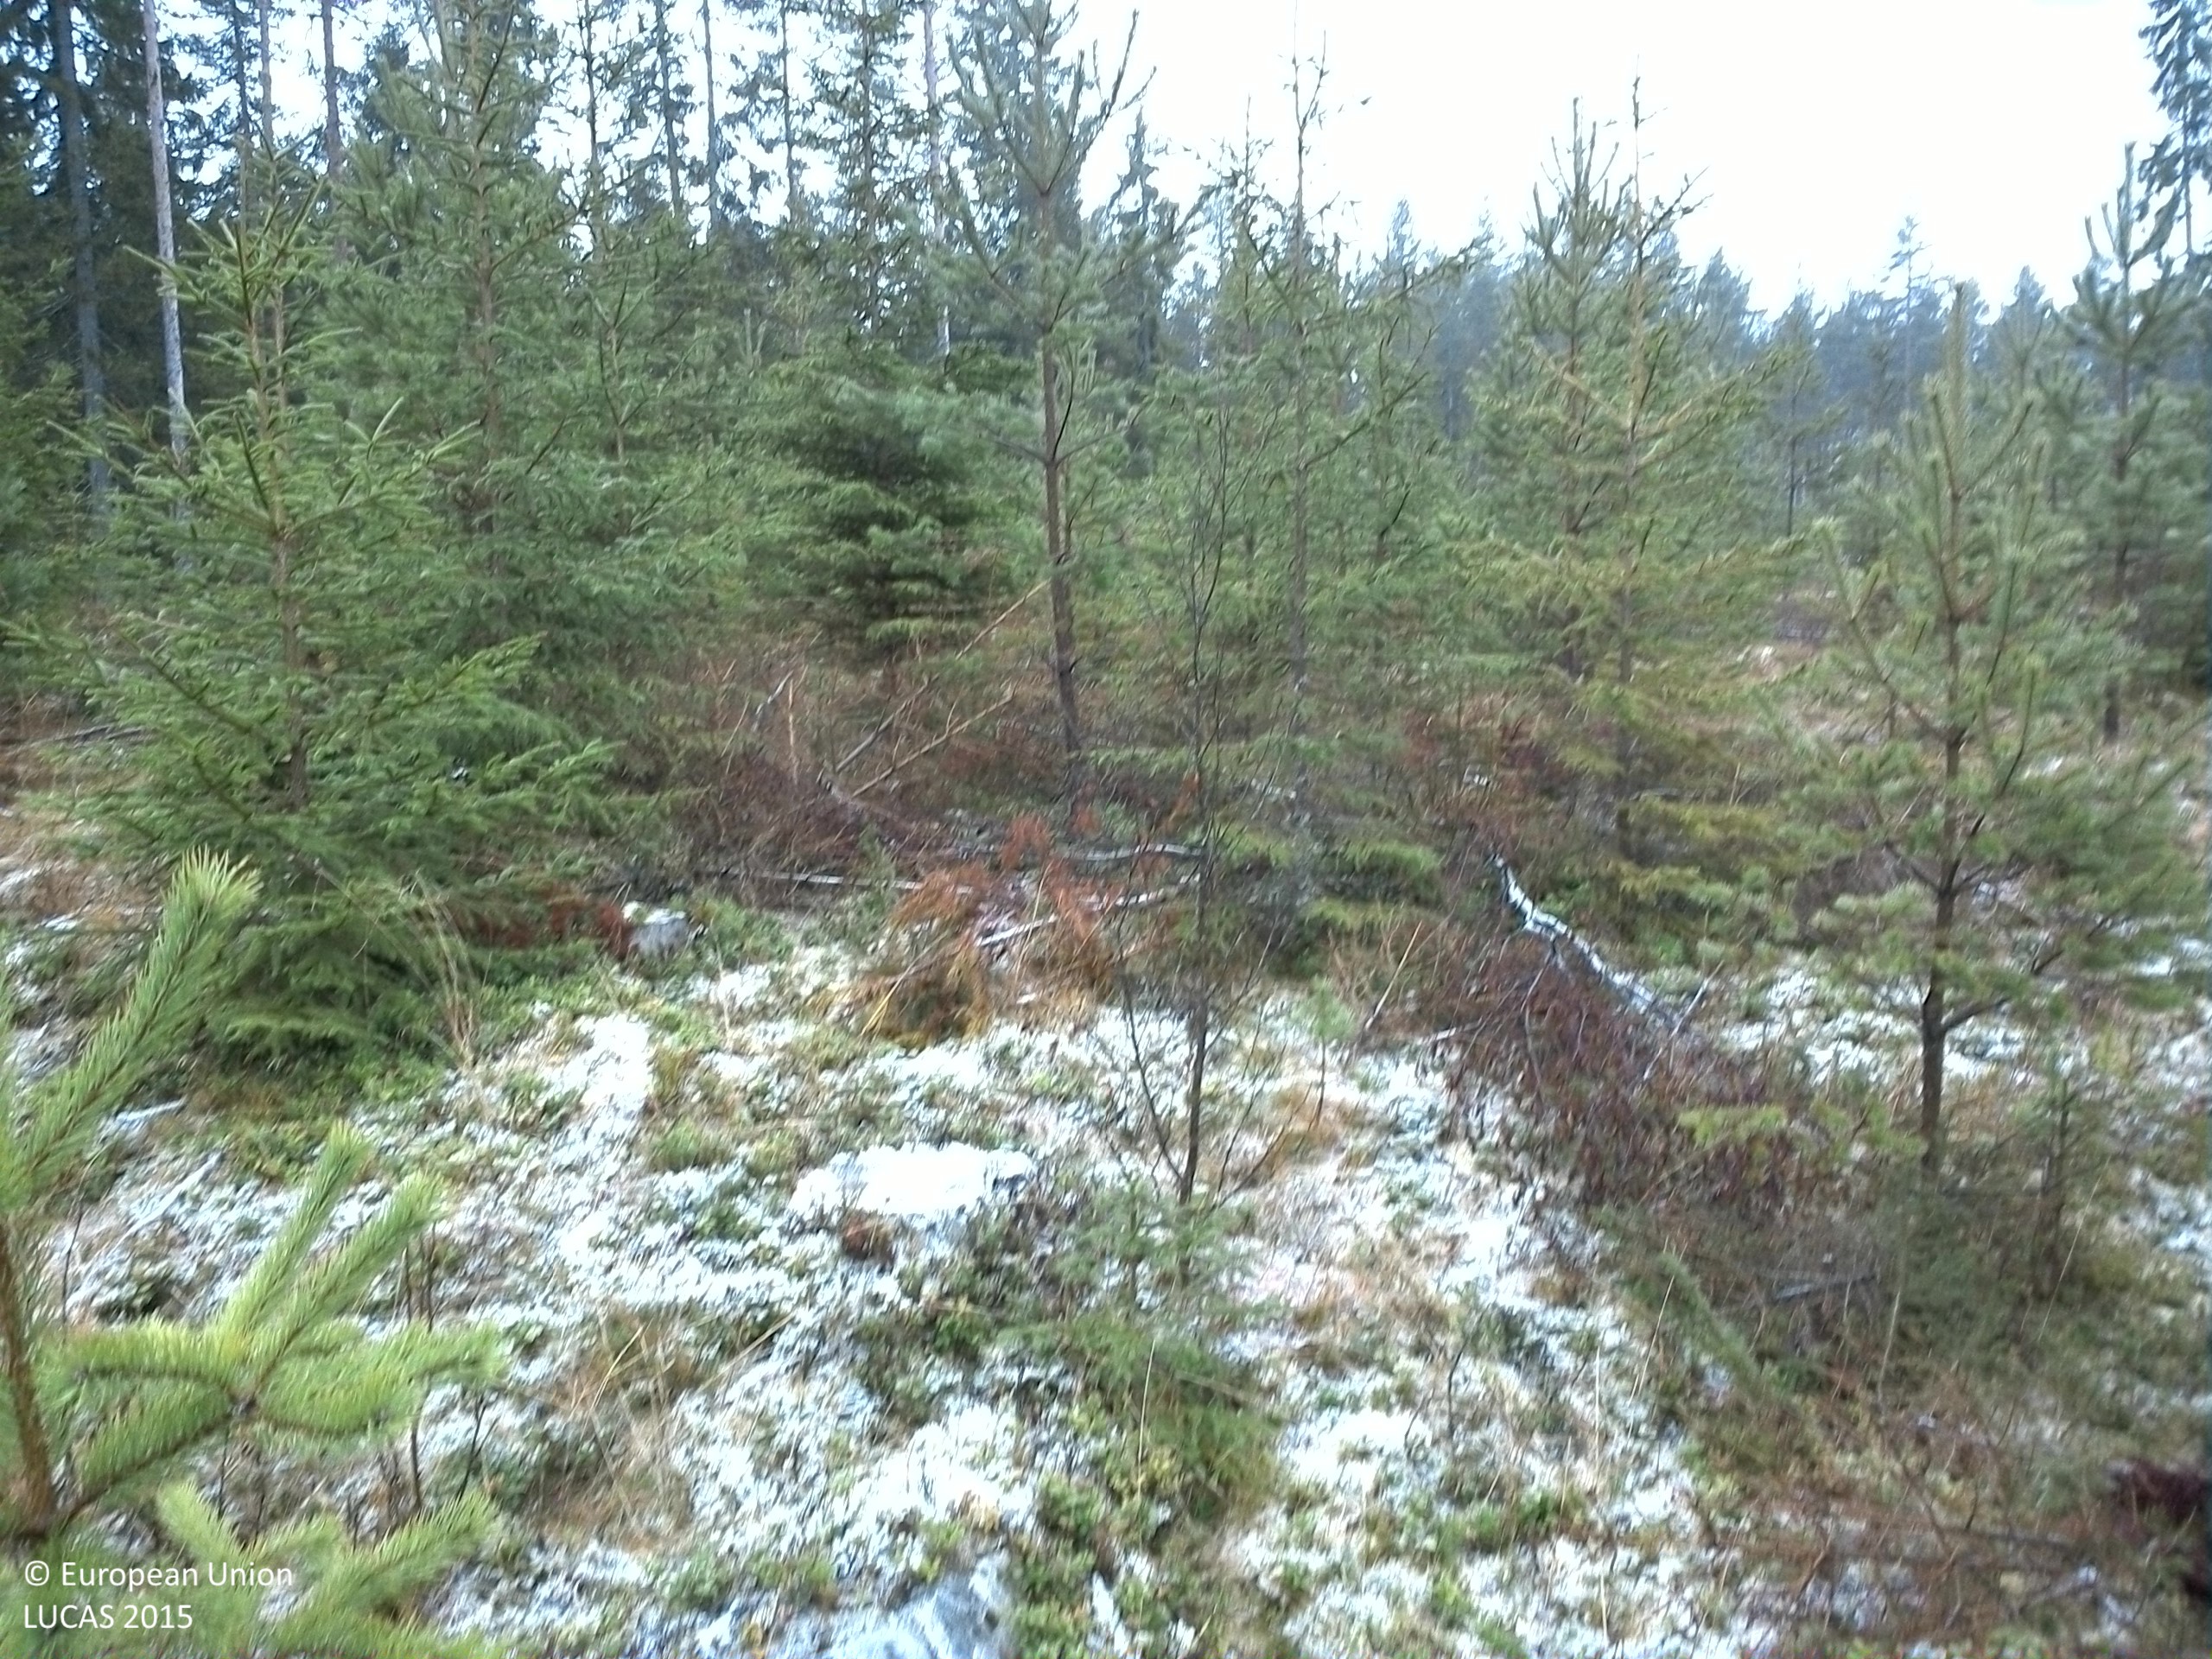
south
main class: Woodland
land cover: Other coniferous woodland
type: boreal forest
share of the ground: 50 - 75 %
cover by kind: coniferous forest trees 65 %, shrubs 15 %, herbaceous plants 10 %, broadleaved forest trees 5 %, consolidated bare surface 5 %
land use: Forestry
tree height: < 5 m
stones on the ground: < 10 %
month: November
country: SE
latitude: 60.2959
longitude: 16.6293
